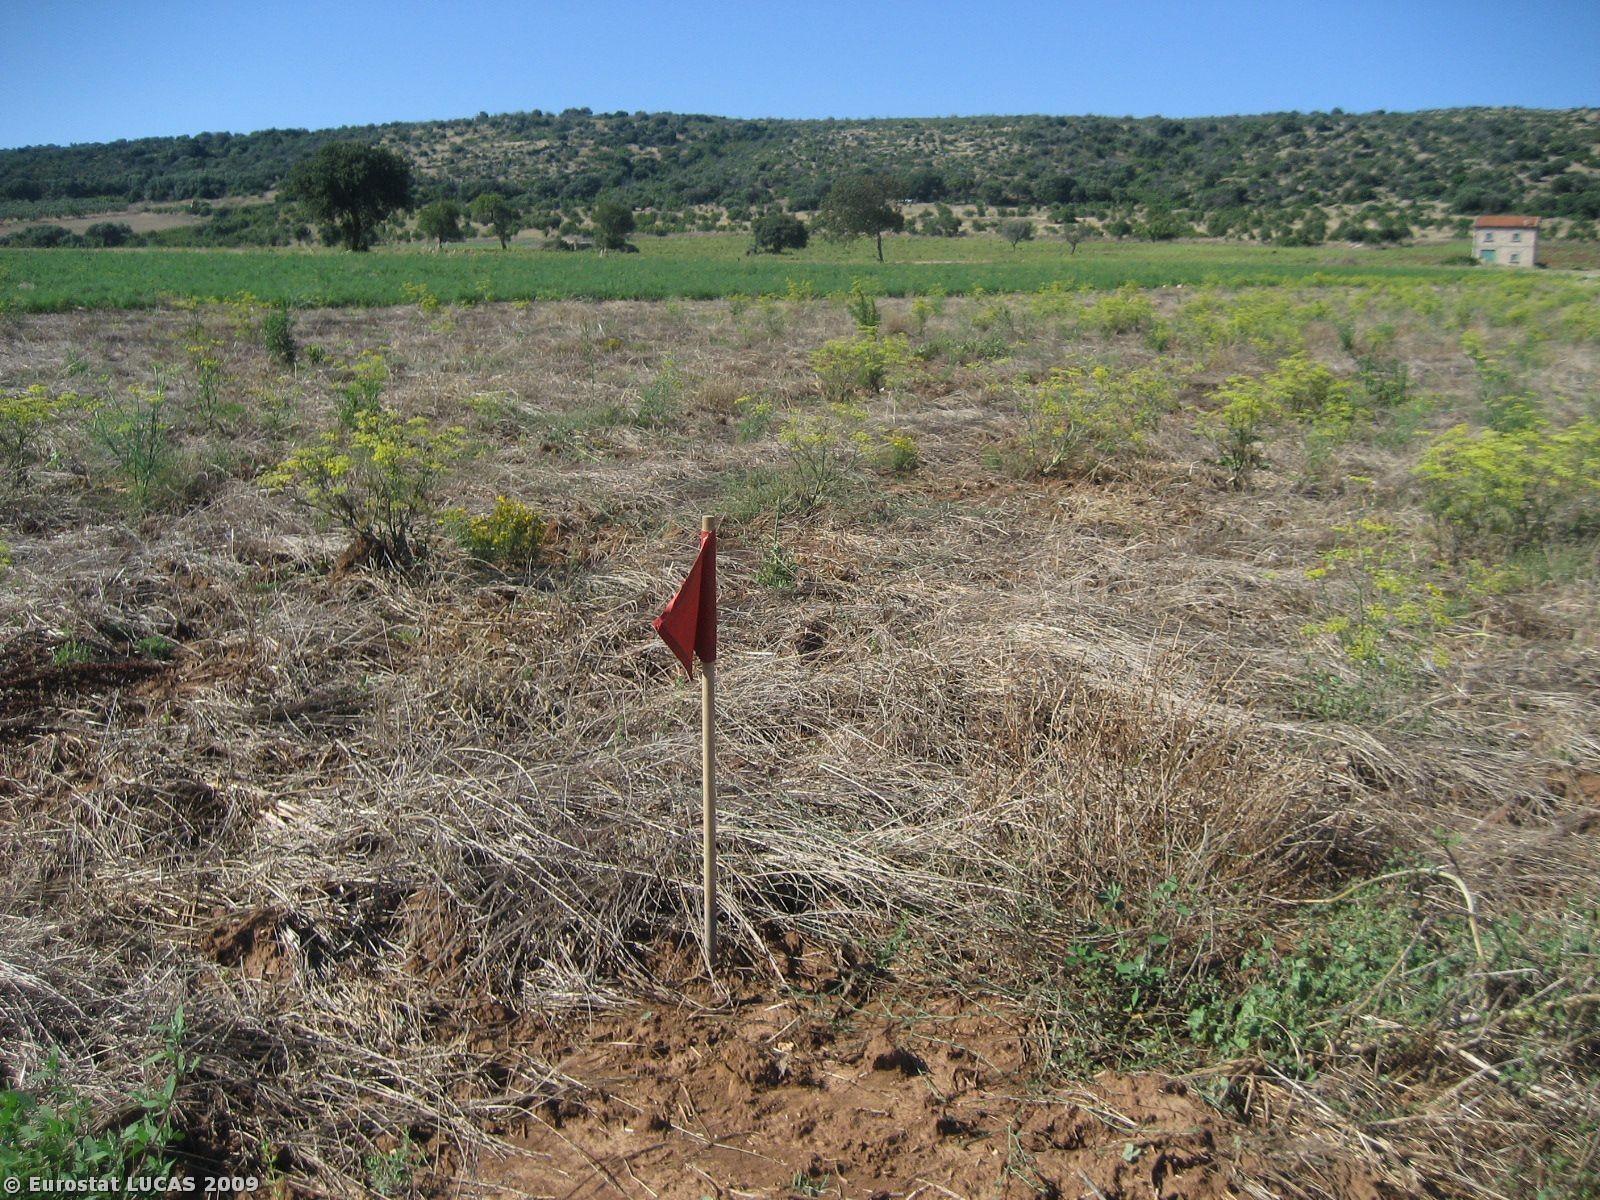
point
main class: Grassland
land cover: Spontaneously vegetated surfaces
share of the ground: > 75 %
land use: Fallow land
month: July
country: IT
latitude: 41.8995
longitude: 15.6370
